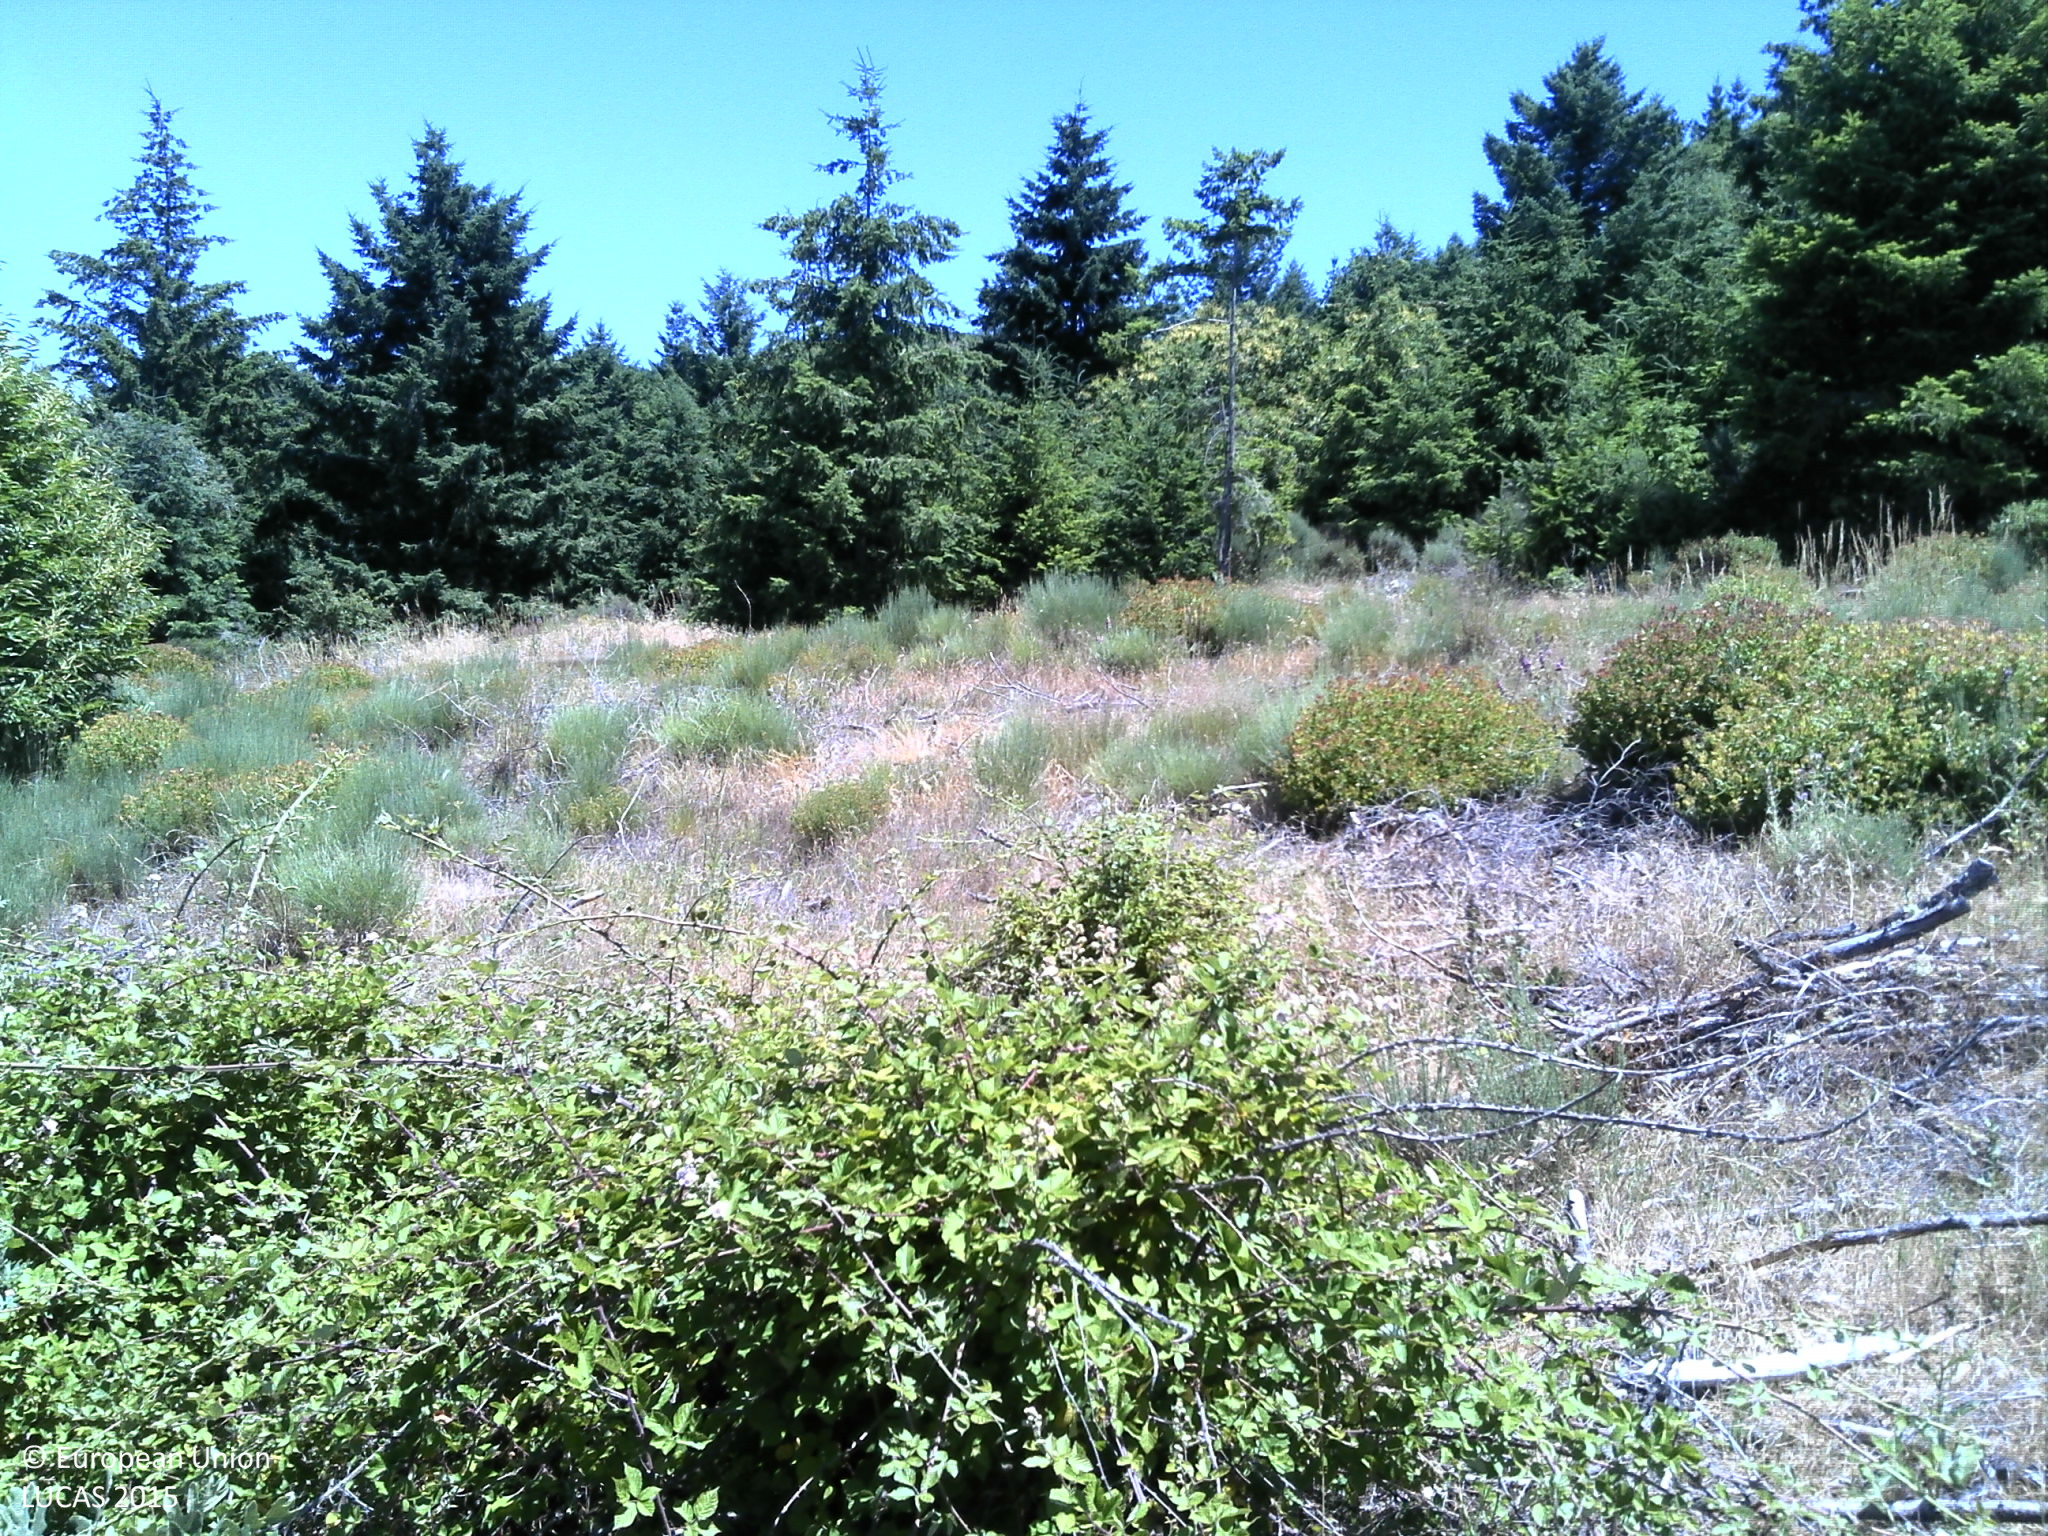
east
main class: Shrubland
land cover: Shrubland with sparse tree cover
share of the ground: > 75 %
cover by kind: shrubs 90 %, coniferous forest trees 5 %, herbaceous plants 5 %
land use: Abandoned areas
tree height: < 5 m
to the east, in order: Shrubland with sparse tree cover; Other coniferous woodland; Broadleaved woodland
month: June
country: PT
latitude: 41.4652
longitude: -6.9837
